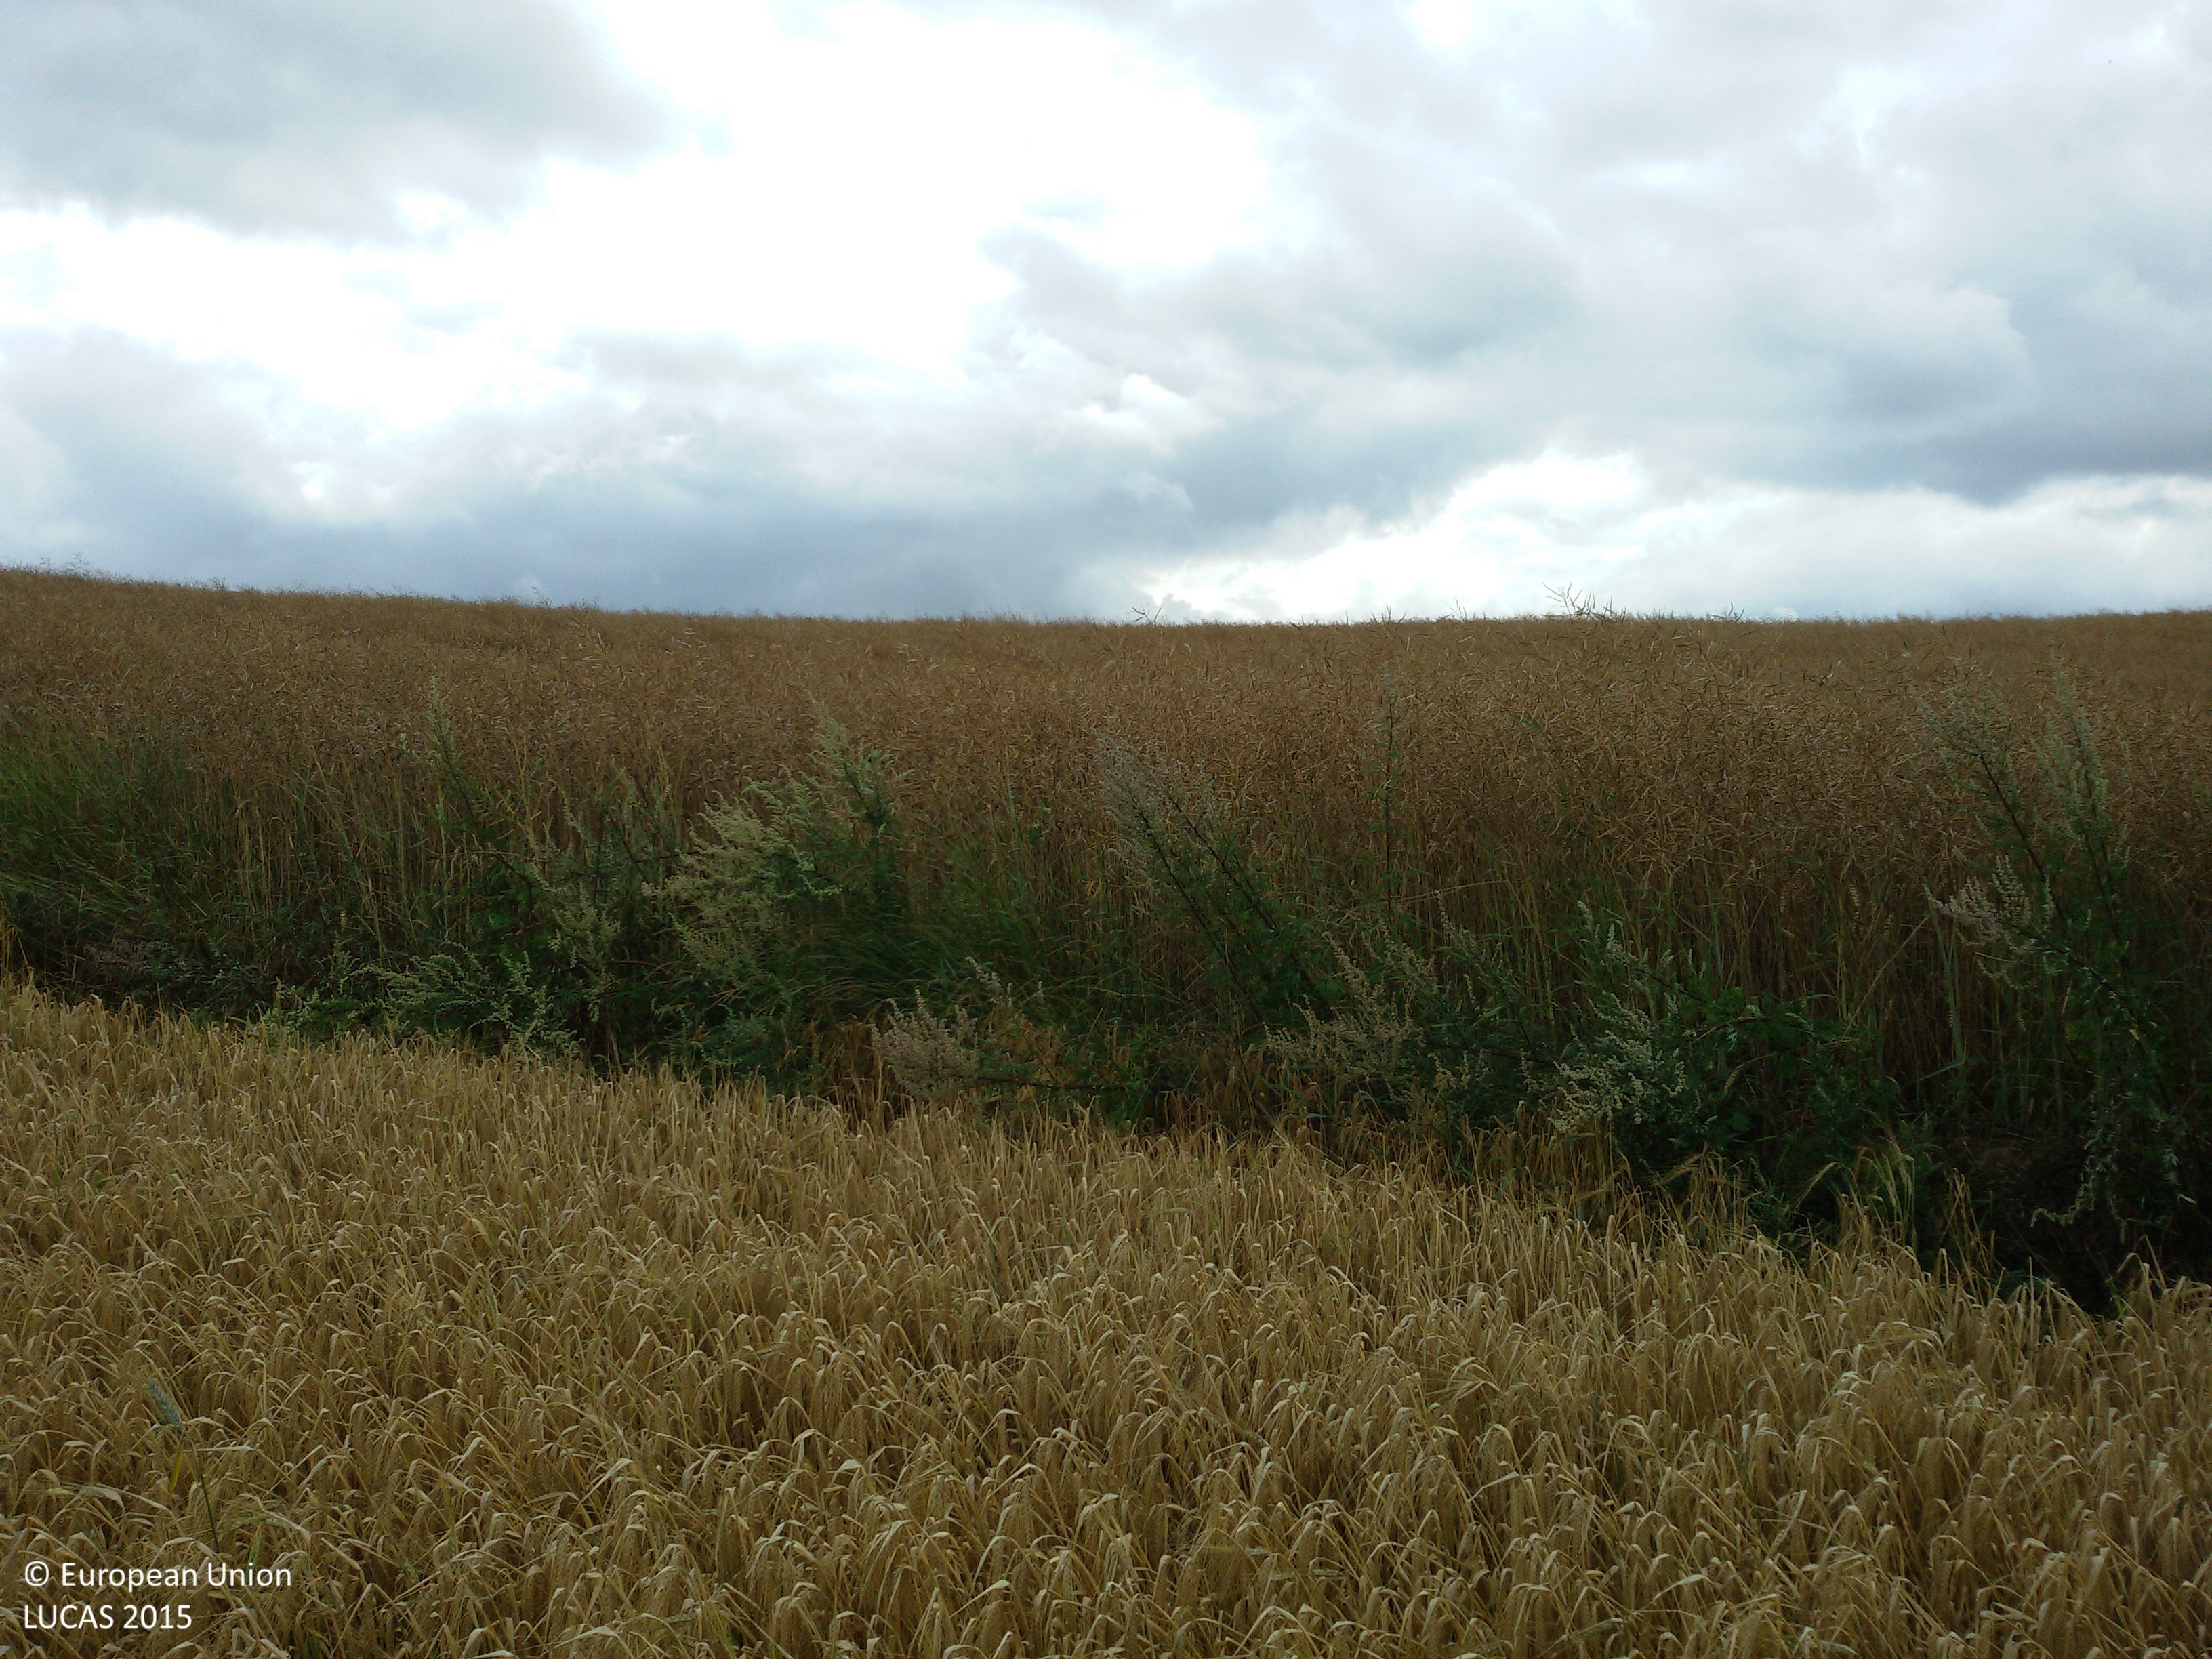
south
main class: Cropland
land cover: Barley
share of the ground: > 75 %
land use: Agriculture (excluding fallow land and kitchen gardens)
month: July
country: PL
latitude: 52.9845
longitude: 19.1248
